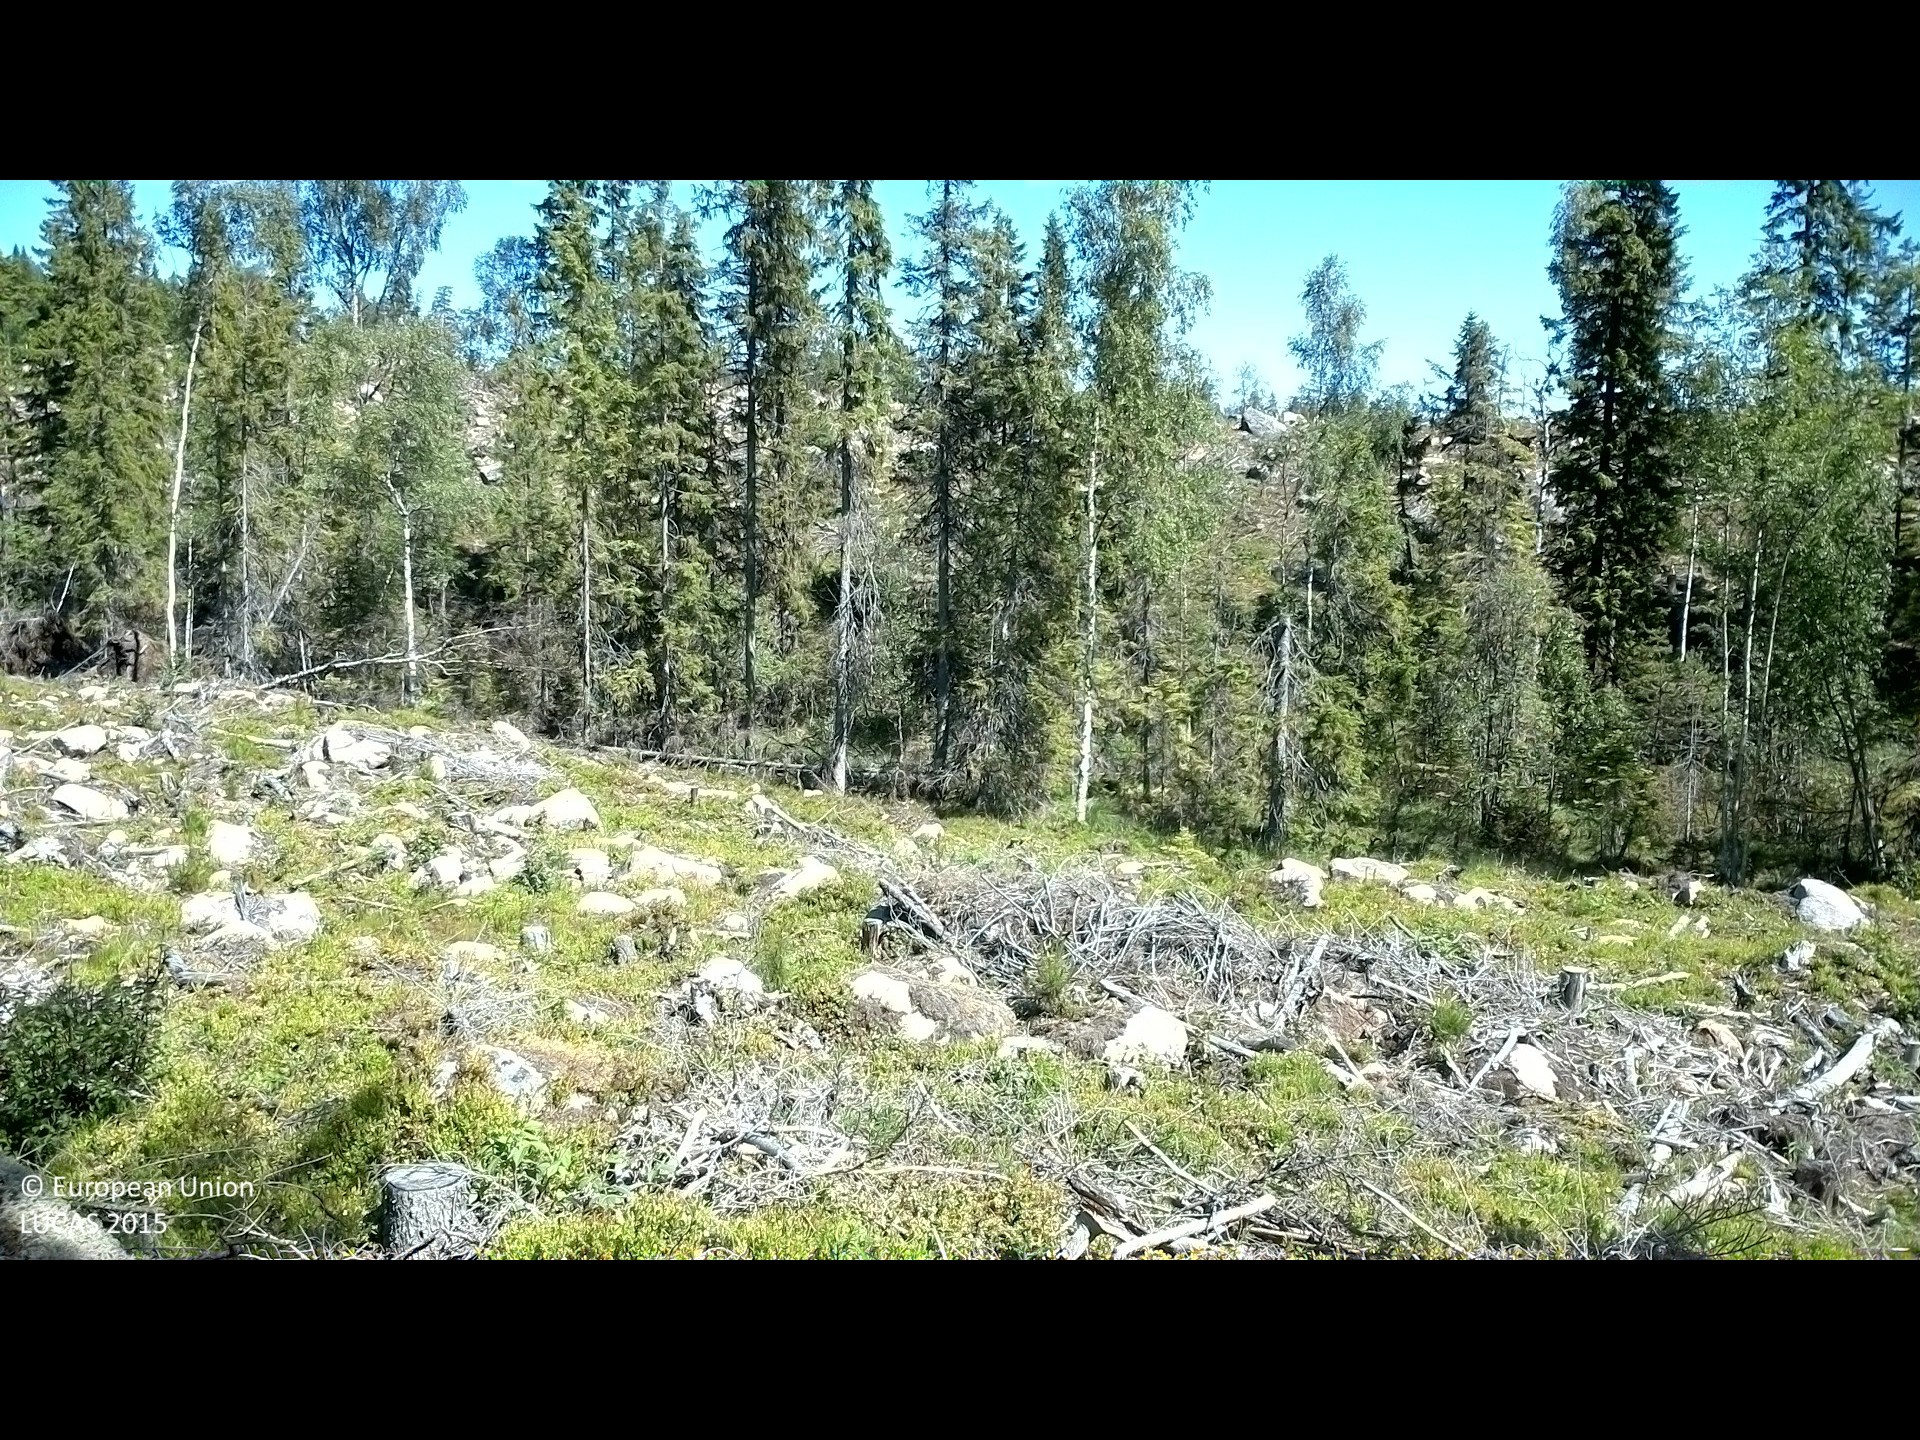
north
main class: Woodland
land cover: Spruce dominated coniferous woodland
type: boreal forest
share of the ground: 10 - 25 %
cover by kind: shrubs 55 %, coniferous forest trees 20 %, lichens and mosses 20 %, broadleaved forest trees 5 %
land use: Forestry
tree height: > 5 m
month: June
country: SE
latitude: 62.0148
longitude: 16.1900
